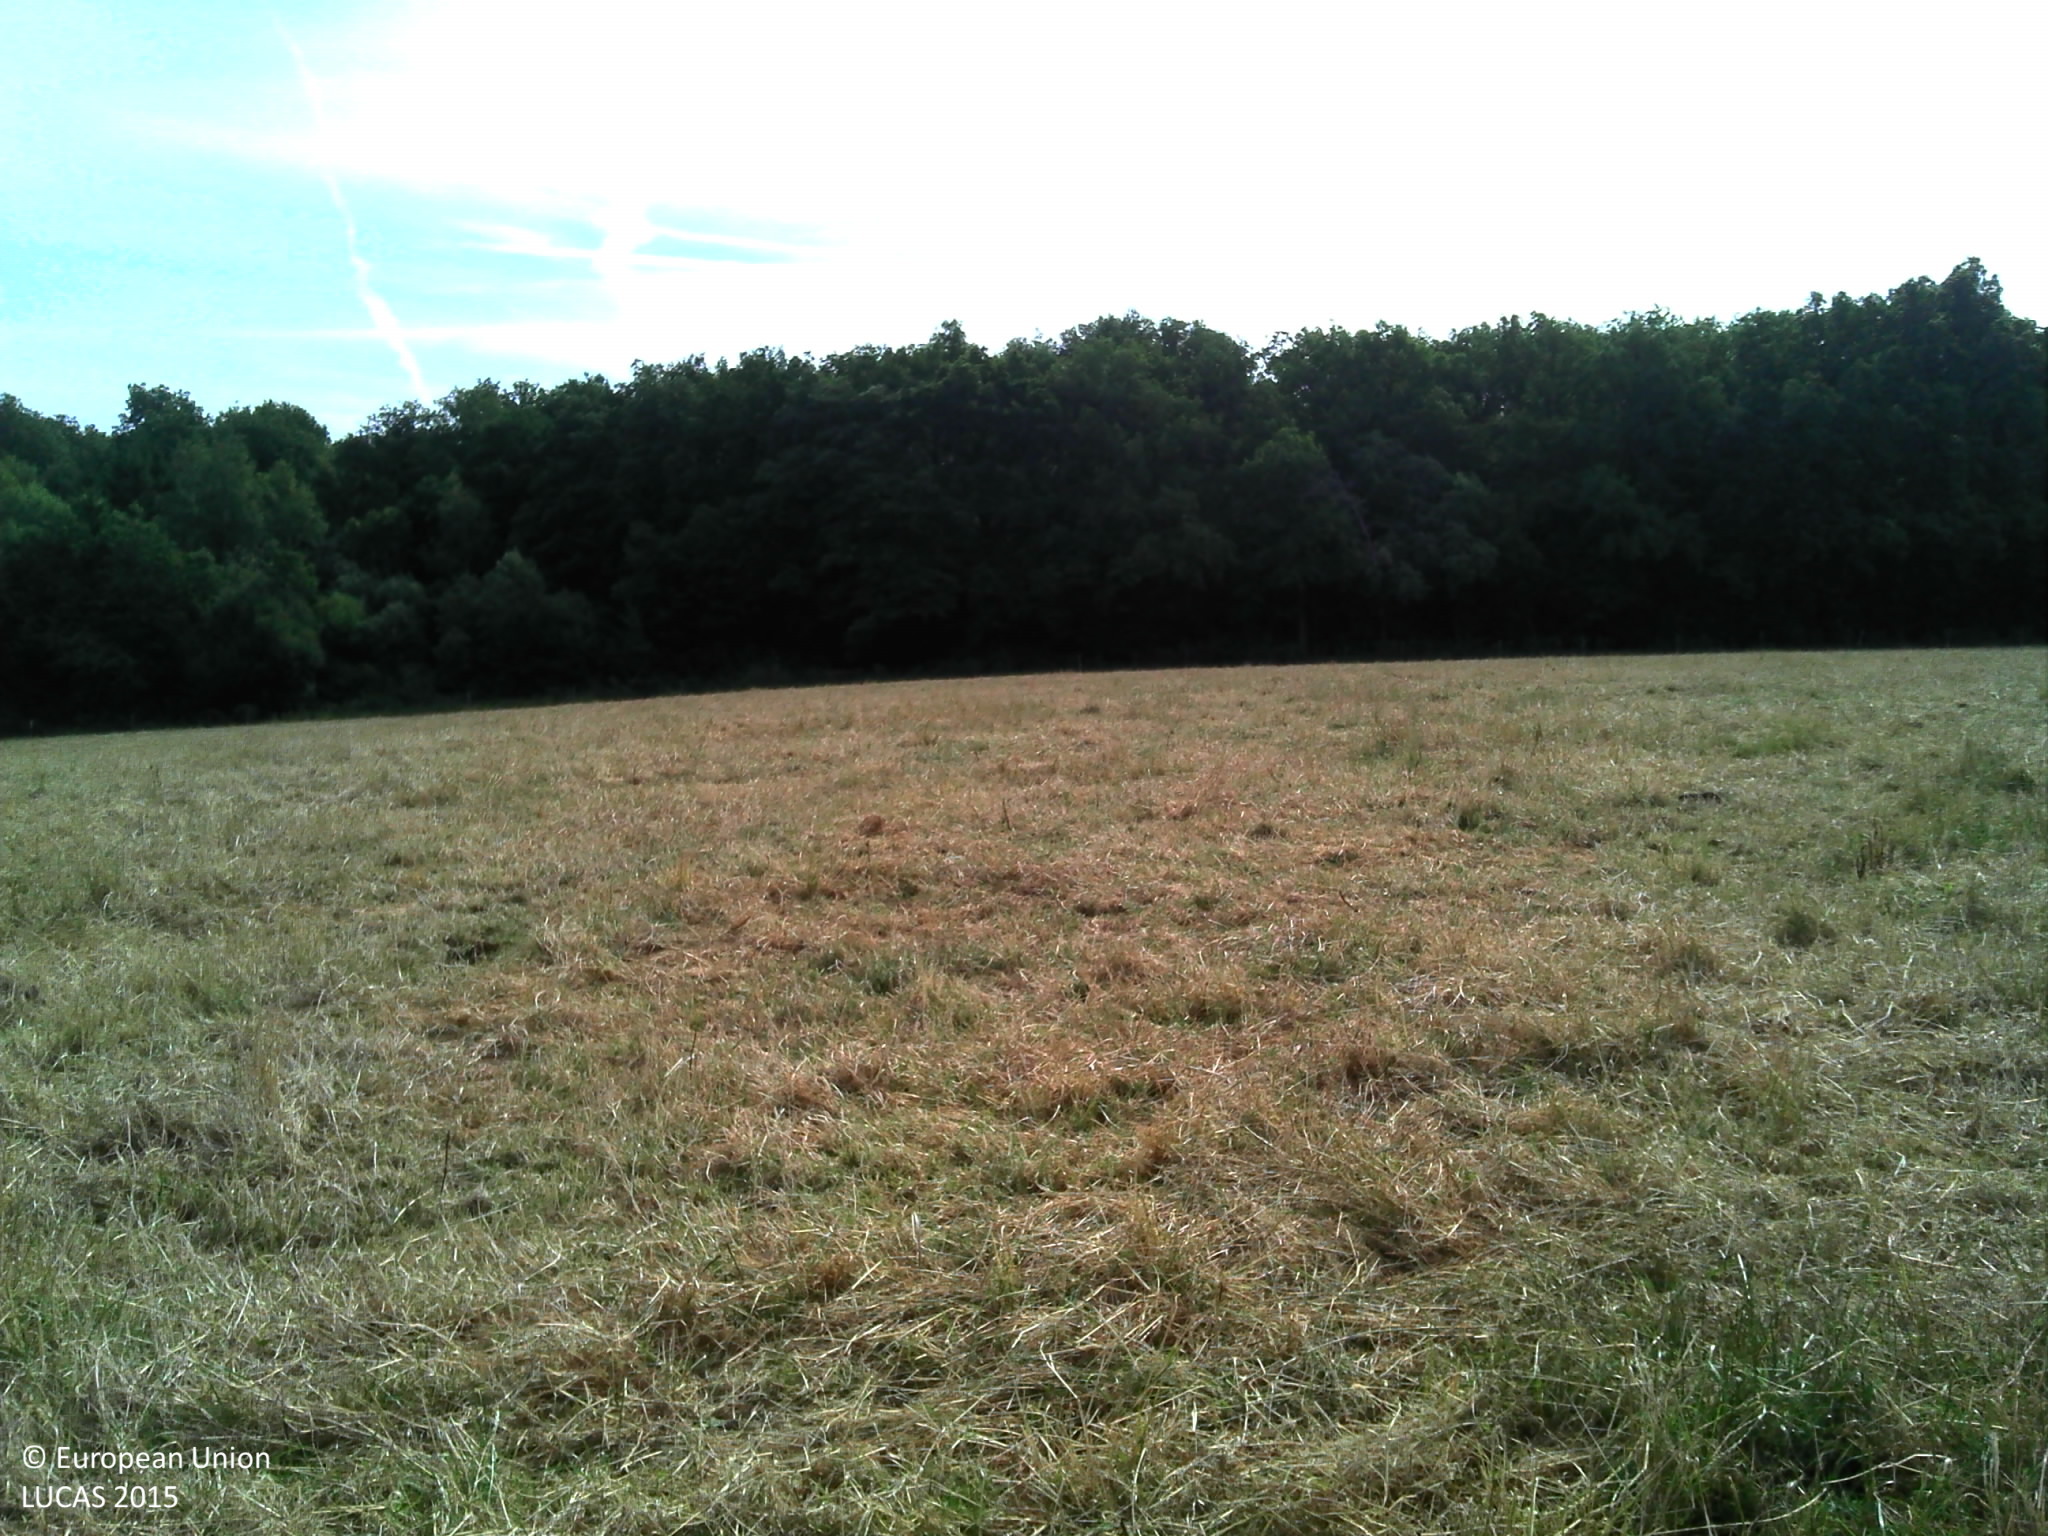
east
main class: Grassland
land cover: Grassland without tree/shrub cover
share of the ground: > 75 %
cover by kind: herbaceous plants 100 %
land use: Agriculture (excluding fallow land and kitchen gardens)
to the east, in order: Grassland without tree/shrub cover; Fences; Managed hedges; Grass margins; Broadleaved woodland
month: July
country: BE
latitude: 49.7476
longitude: 5.8216
